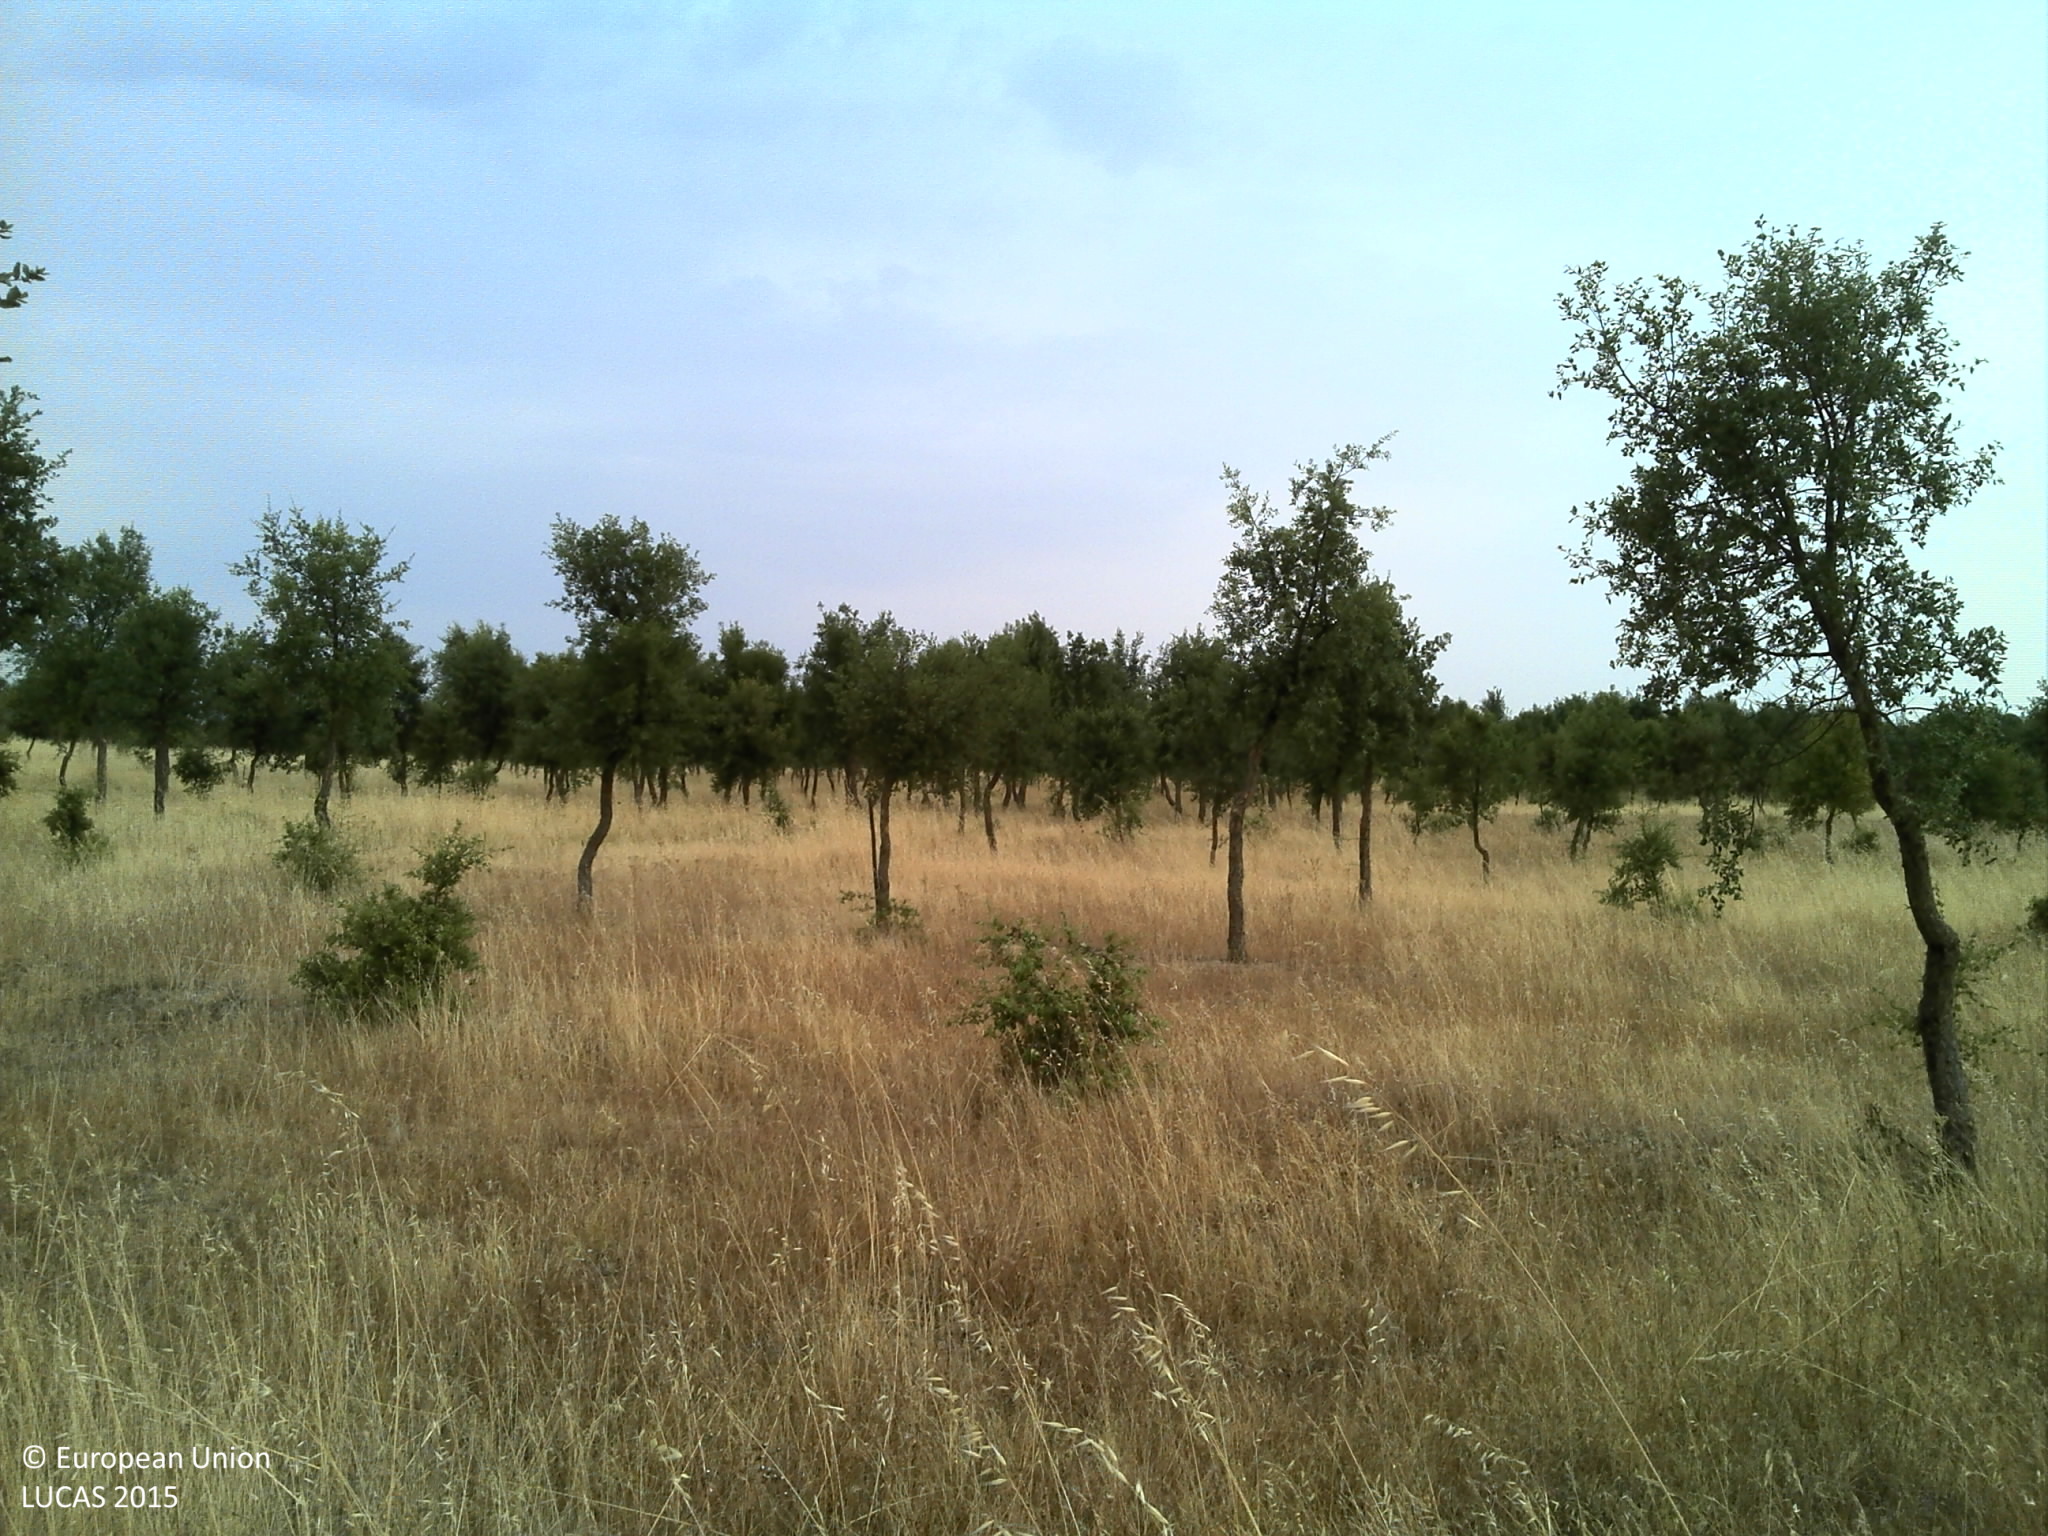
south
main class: Woodland
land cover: Broadleaved woodland
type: broadleaved evergreen forest
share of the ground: 25 - 50 %
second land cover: Grassland without tree/shrub cover
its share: 50 - 75 %
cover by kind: herbaceous plants 60 %, broadleaved forest trees 30 %, unconsolidated bare surface 10 %
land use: Forestry
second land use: Agriculture (excluding fallow land and kitchen gardens)
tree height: < 5 m
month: June
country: PT
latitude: 38.6318
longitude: -7.7622
